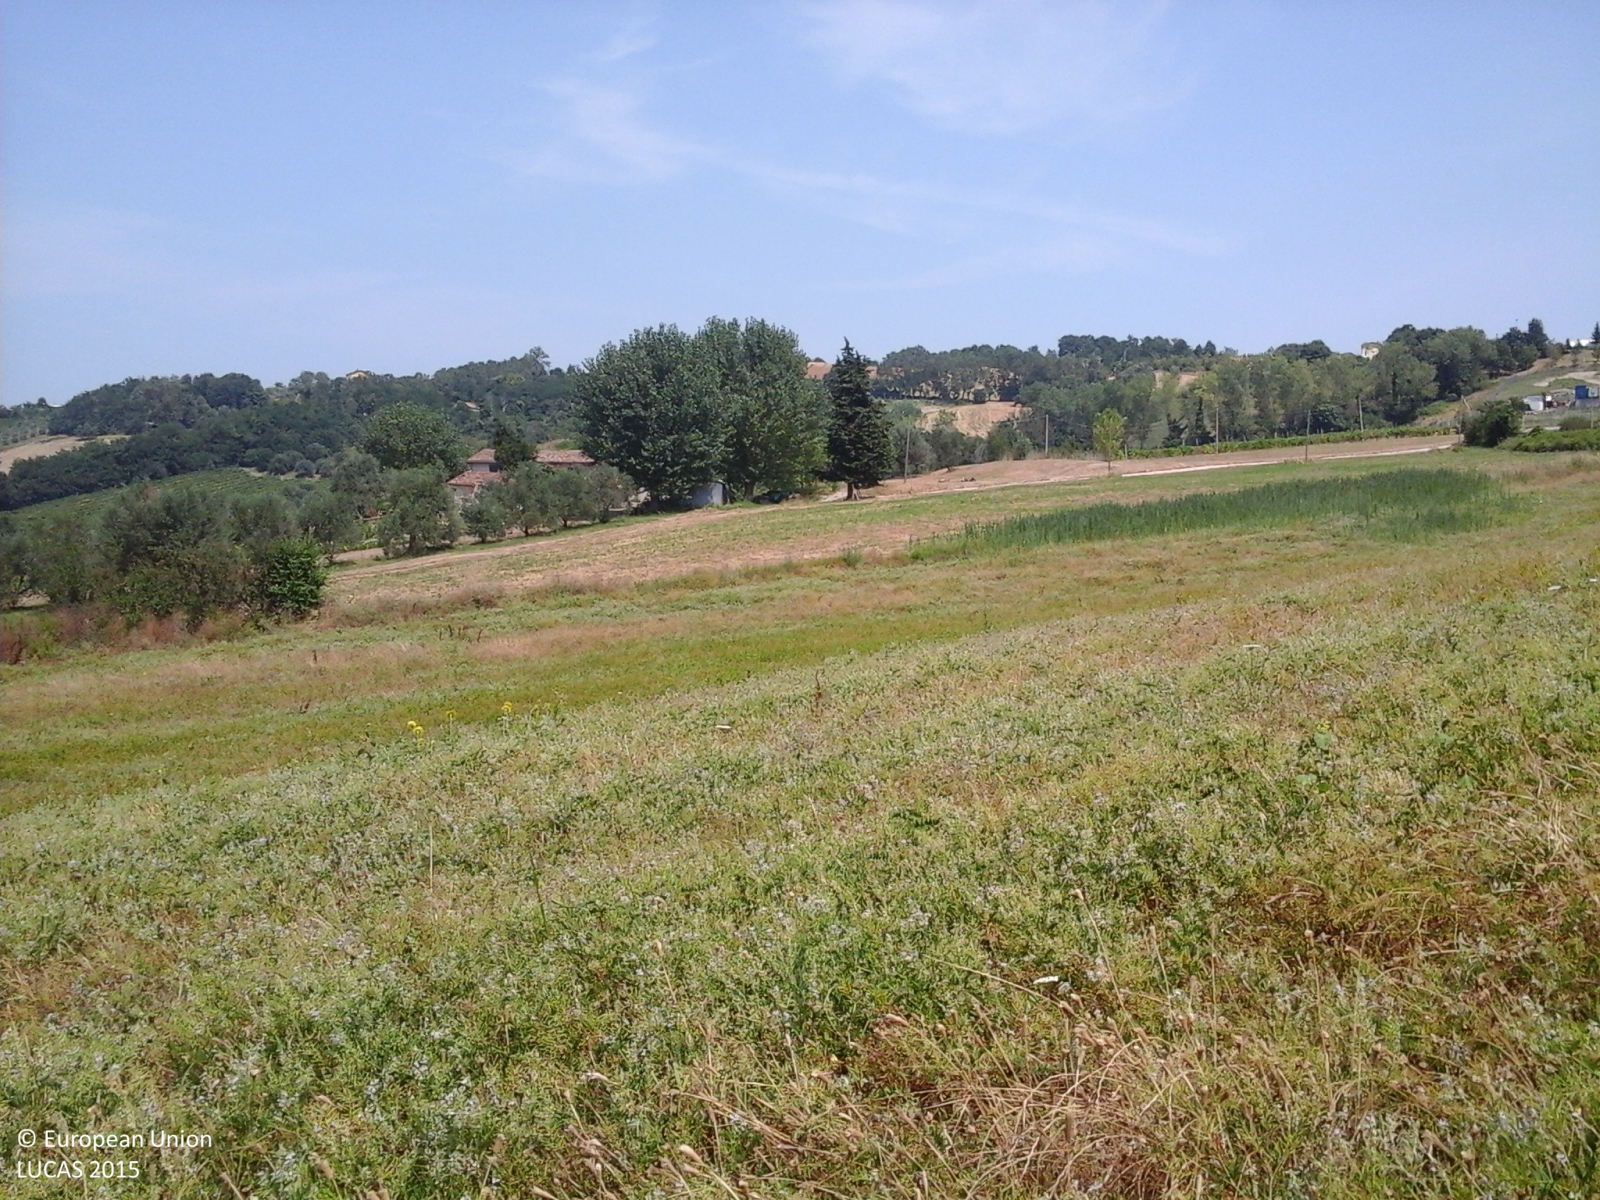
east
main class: Cropland
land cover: Other leguminous and mixtures for fodder
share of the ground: > 75 %
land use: Agriculture (excluding fallow land and kitchen gardens)
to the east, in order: Other leguminous and mixtures for fodder; Grass margins; Ditches and canals; Grass margins; Lucerne; Electric lines; Lucerne; Ditches and canals; Tracks; Grassland without tree/shrub cover; Electric lines; Grassland without tree/shrub cover
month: July
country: IT
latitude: 44.0352
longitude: 12.3529
